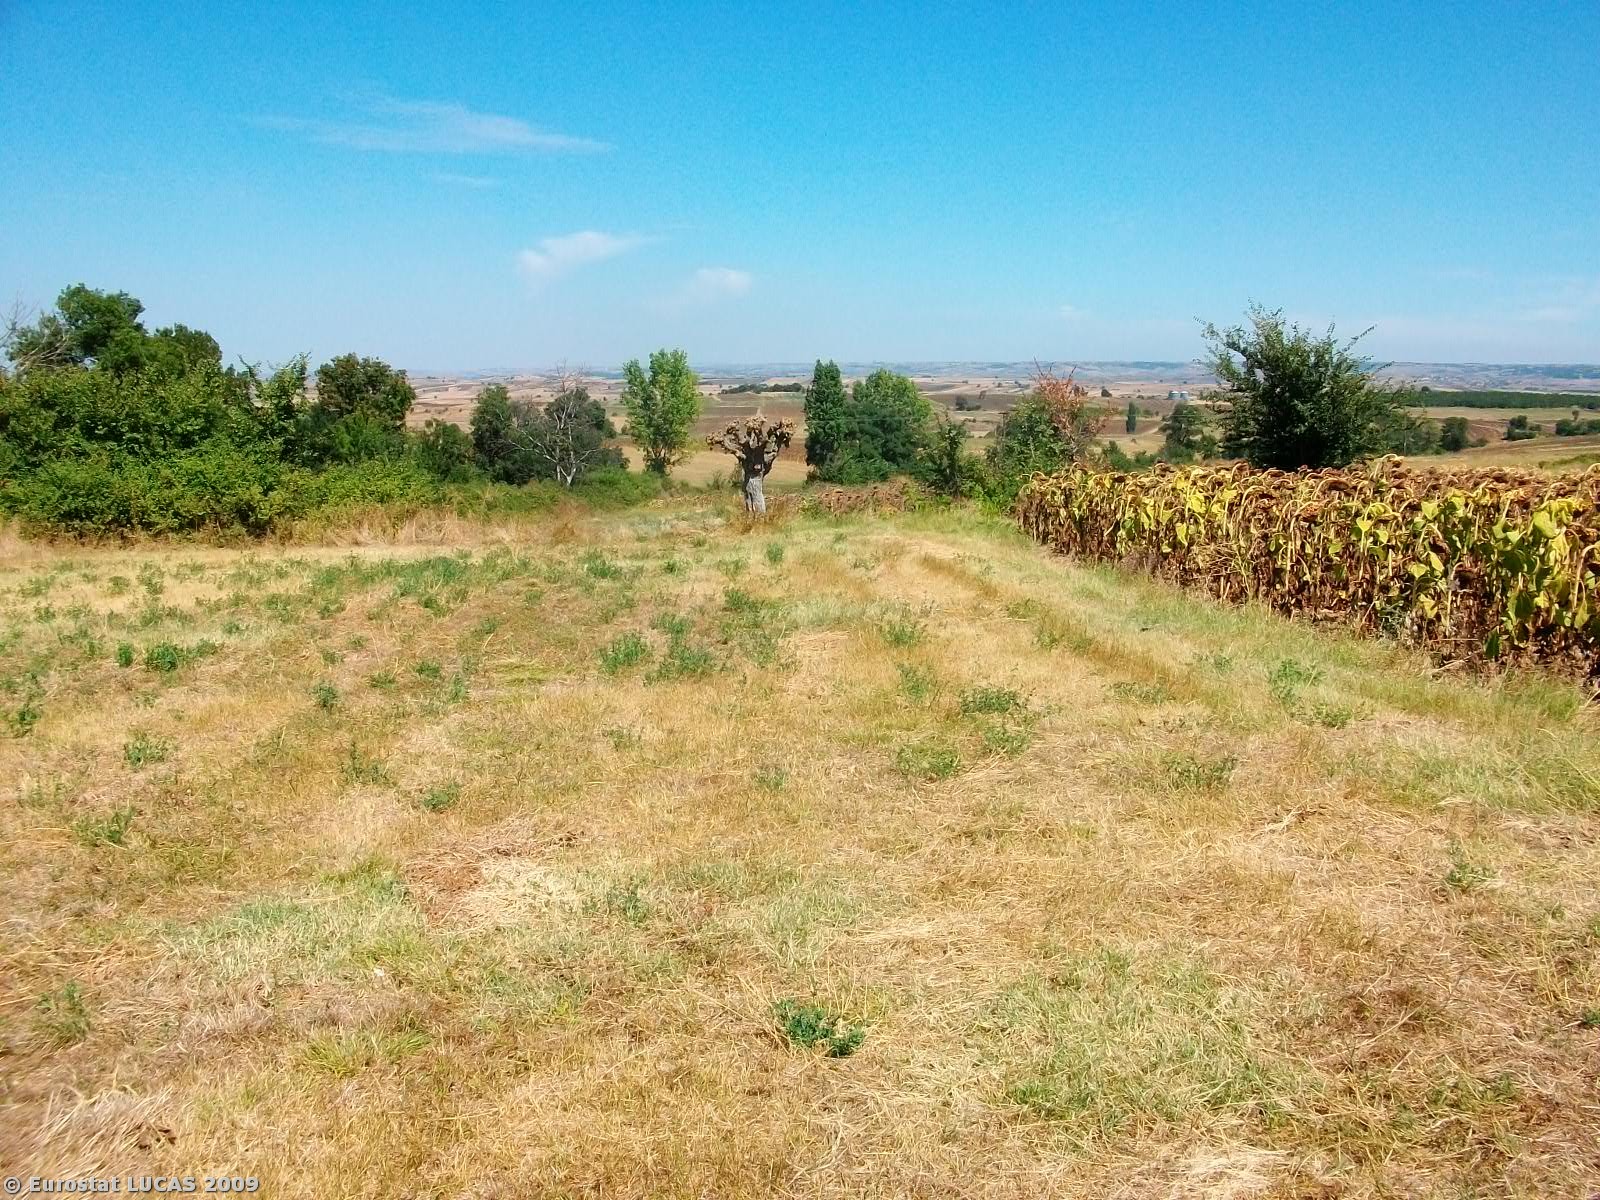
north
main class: Cropland
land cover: Lucerne
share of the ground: < 10 %
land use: Agriculture (excluding fallow land and kitchen gardens)
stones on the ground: < 10 %
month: August
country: GR
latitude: 41.3494
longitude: 26.3639
